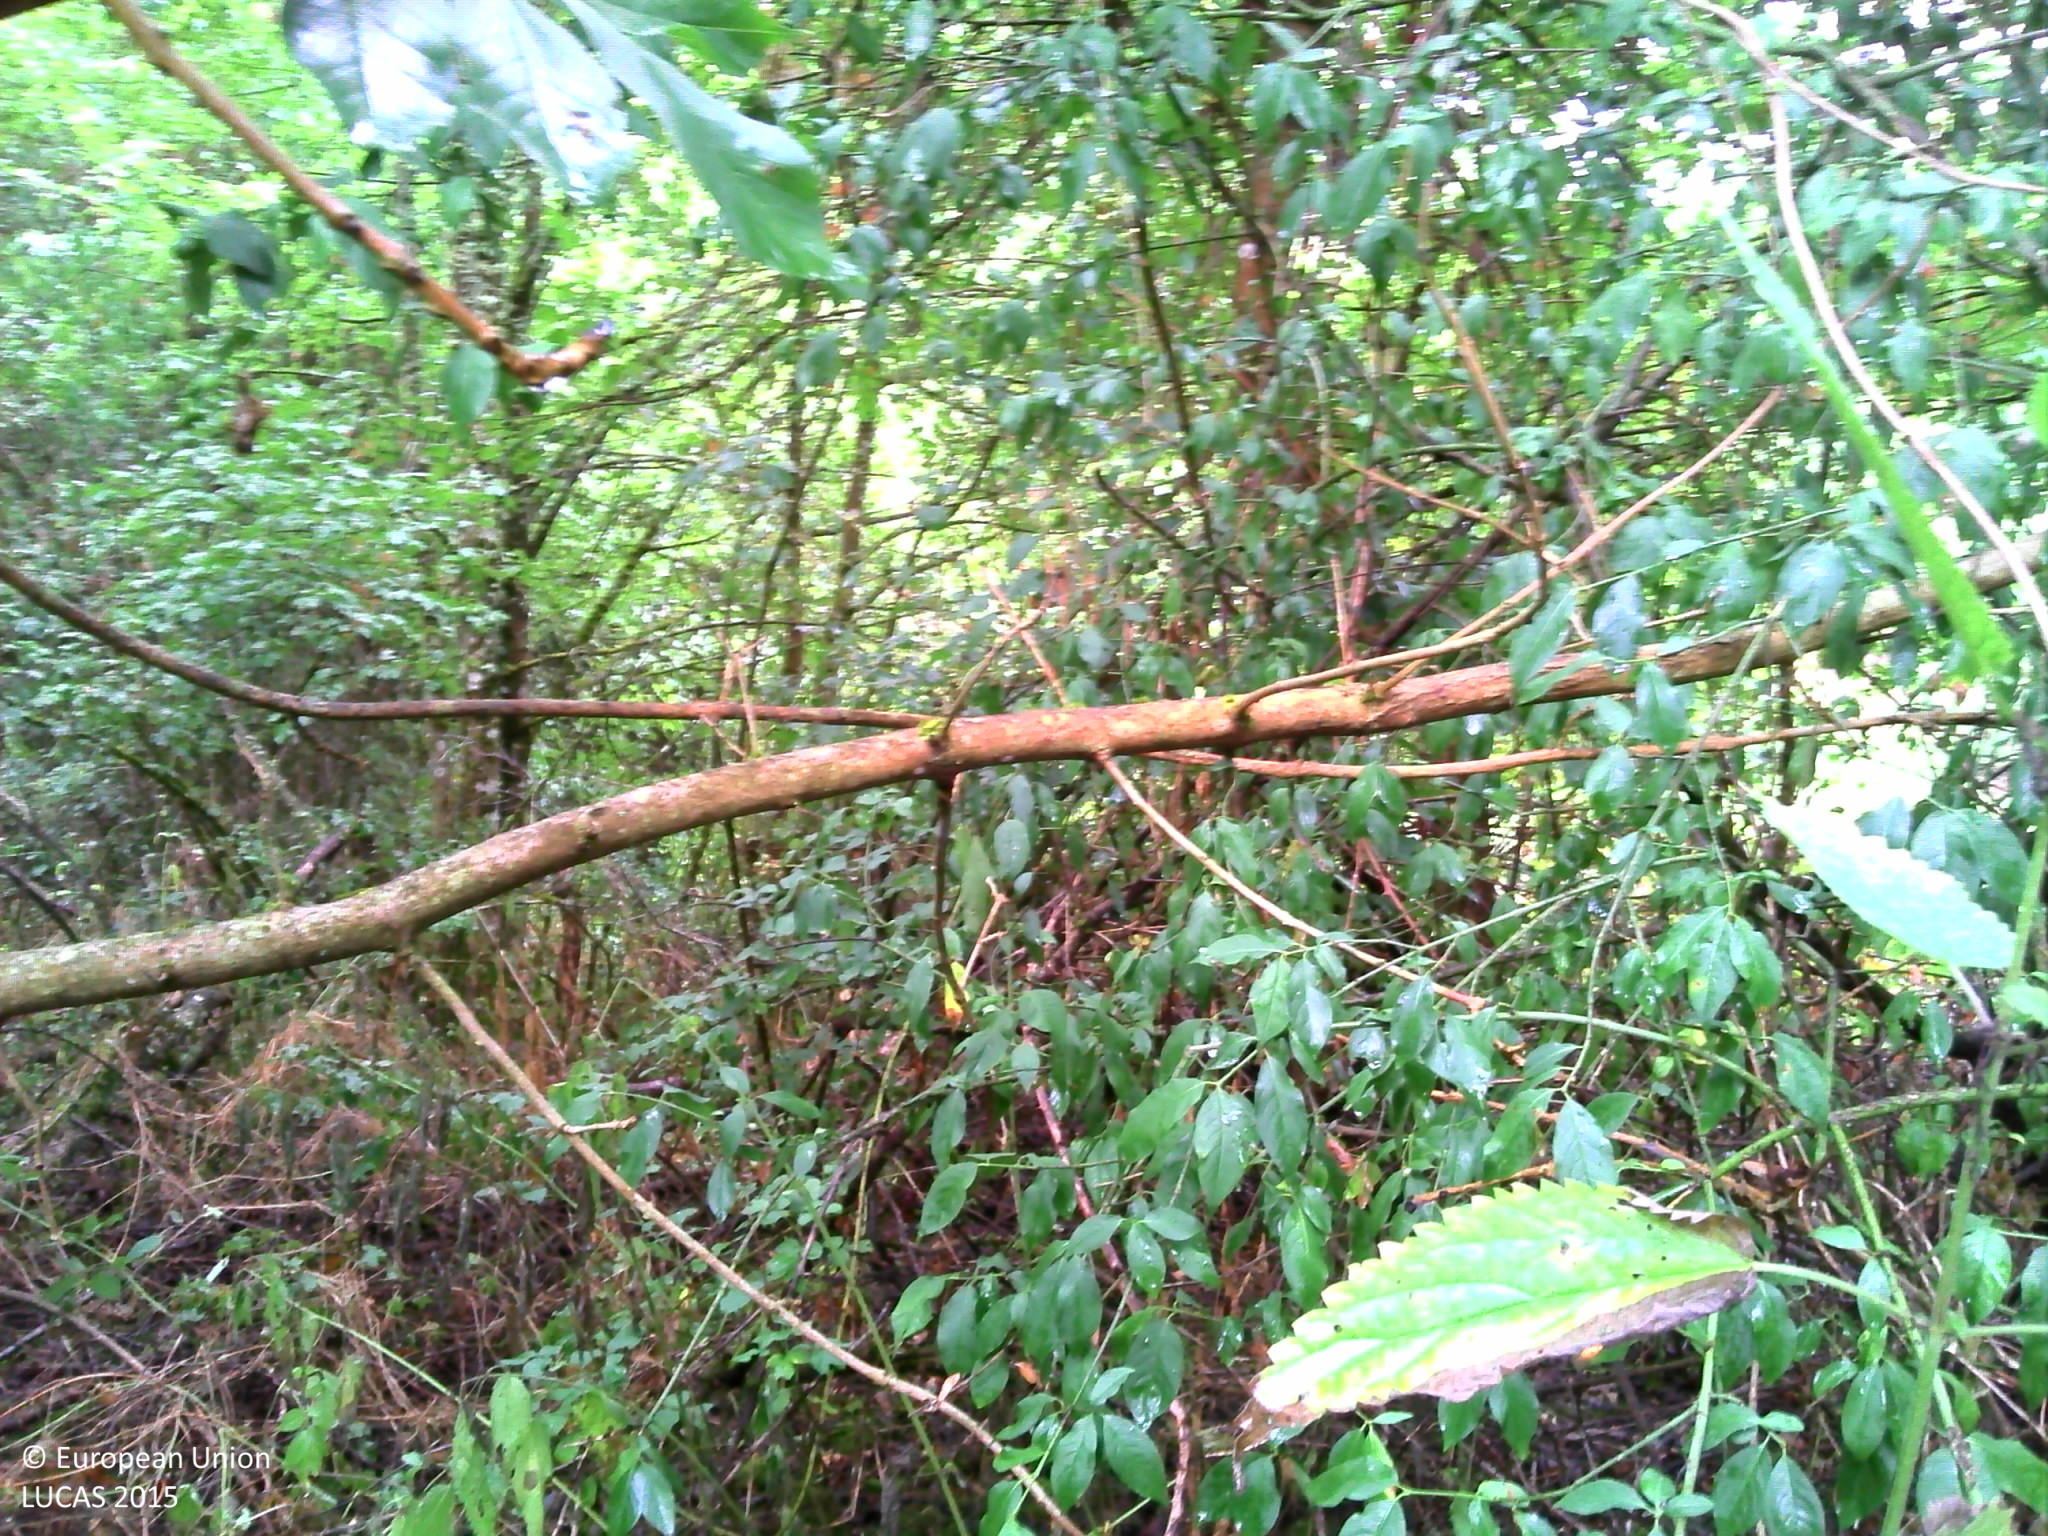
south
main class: Woodland
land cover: Broadleaved woodland
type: mesophytic deciduous forest
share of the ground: > 75 %
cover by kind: broadleaved forest trees 80 %, herbaceous plants 15 %, lichens and mosses 5 %
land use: Semi-natural and natural areas not in use
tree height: > 5 m
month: August
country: FR
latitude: 47.6451
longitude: 3.0854
